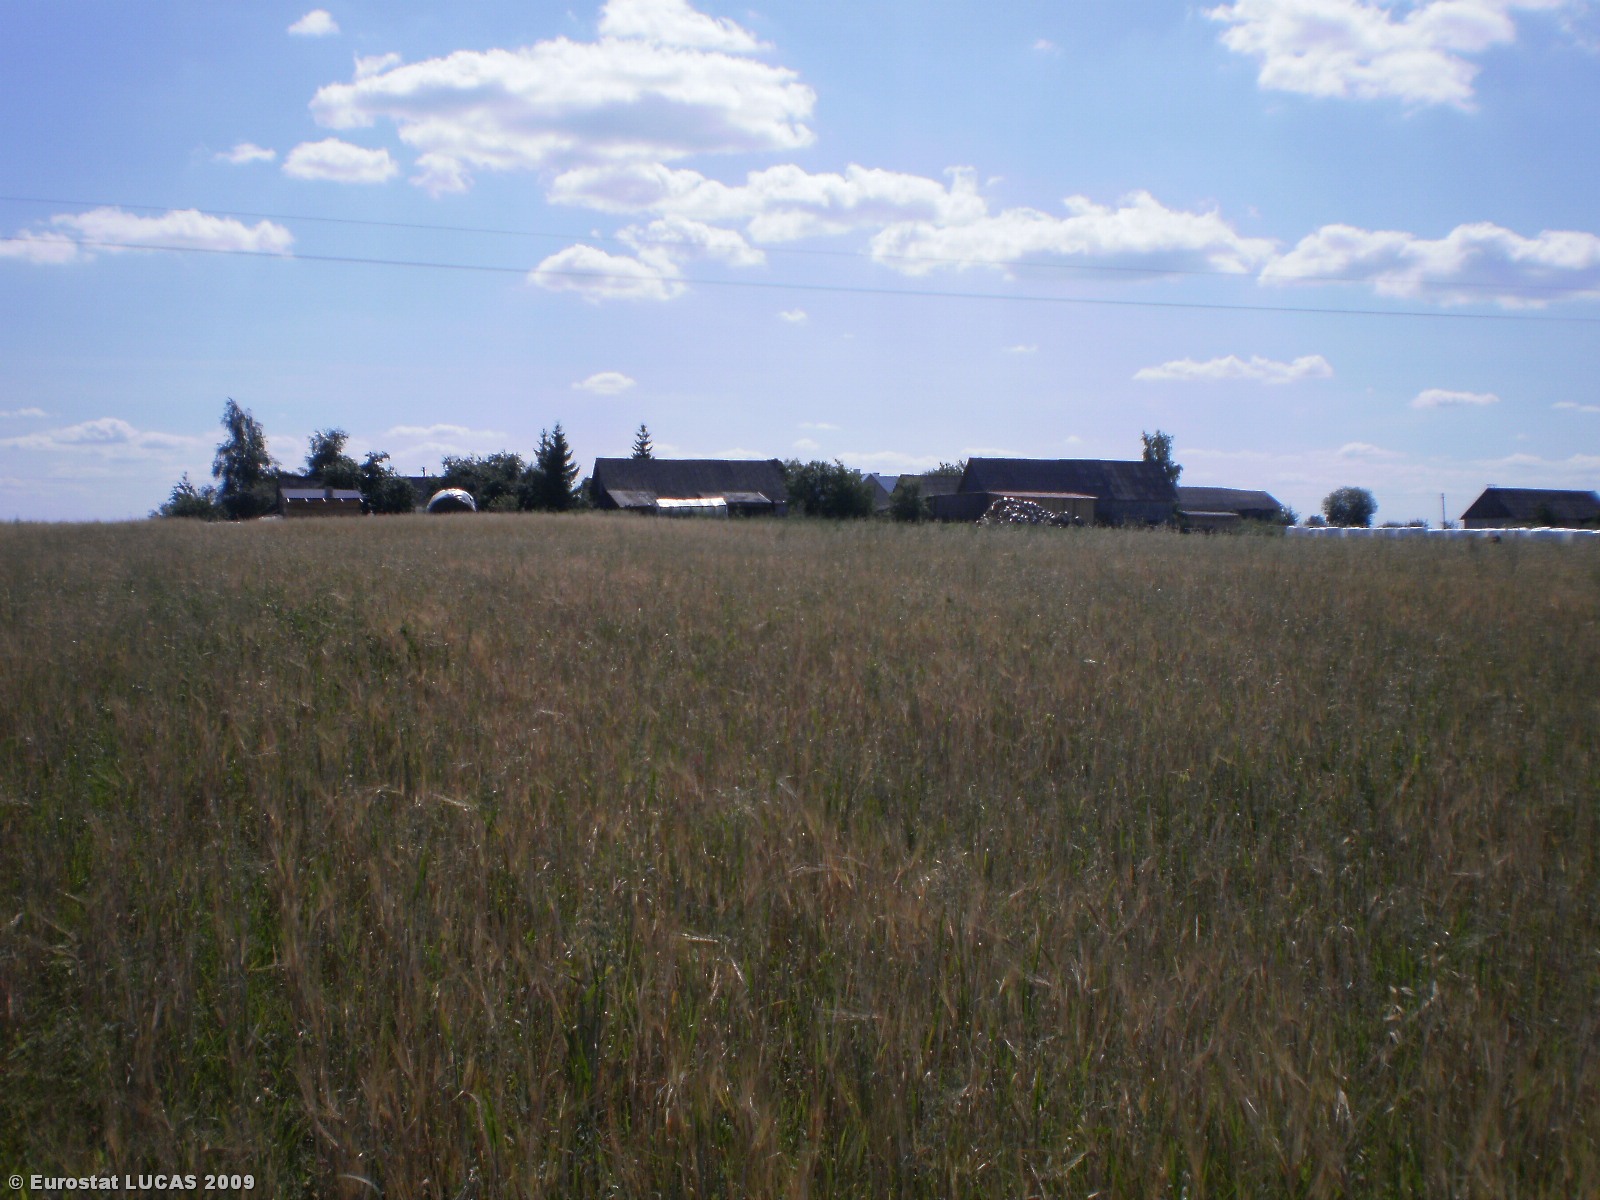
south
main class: Cropland
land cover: Barley
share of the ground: > 75 %
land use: Agriculture (excluding fallow land and kitchen gardens)
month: August
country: LT
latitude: 55.6257
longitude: 25.0246
